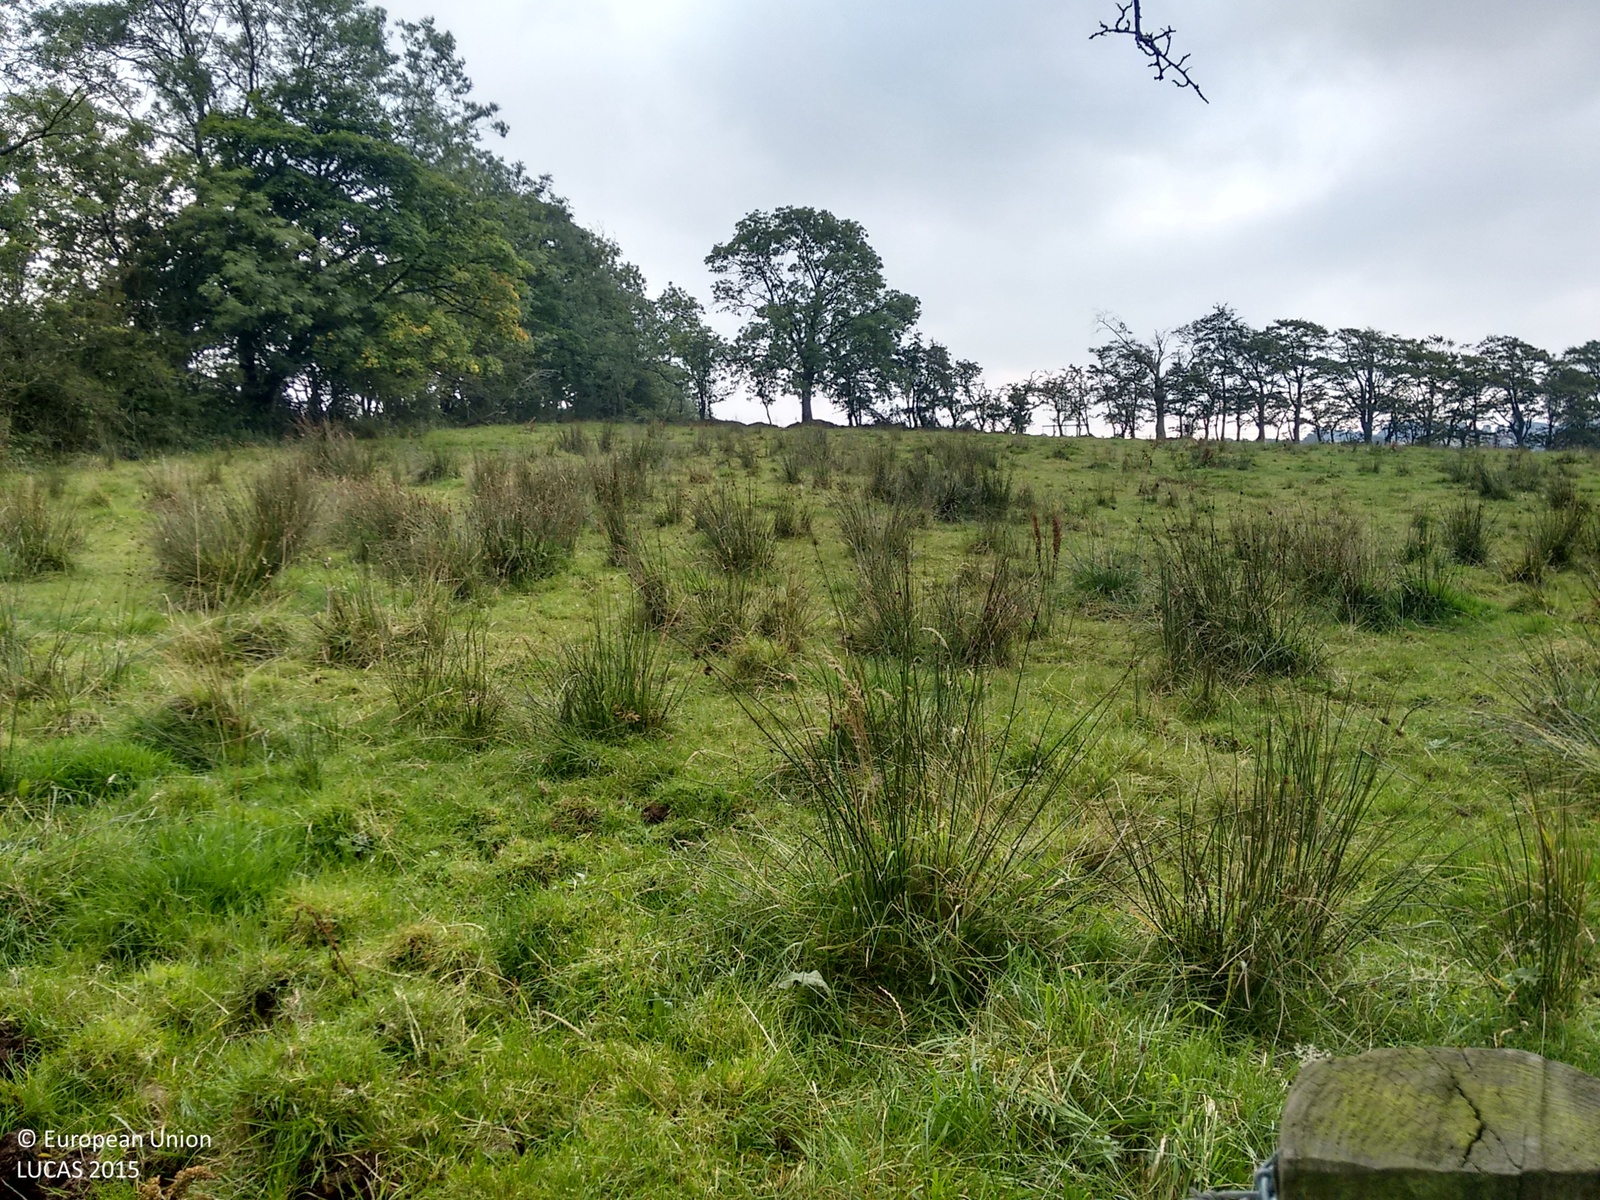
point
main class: Grassland
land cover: Grassland without tree/shrub cover
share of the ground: > 75 %
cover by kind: herbaceous plants 100 %
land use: Agriculture (excluding fallow land and kitchen gardens)
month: September
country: GB
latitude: 54.7859
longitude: -6.0174
